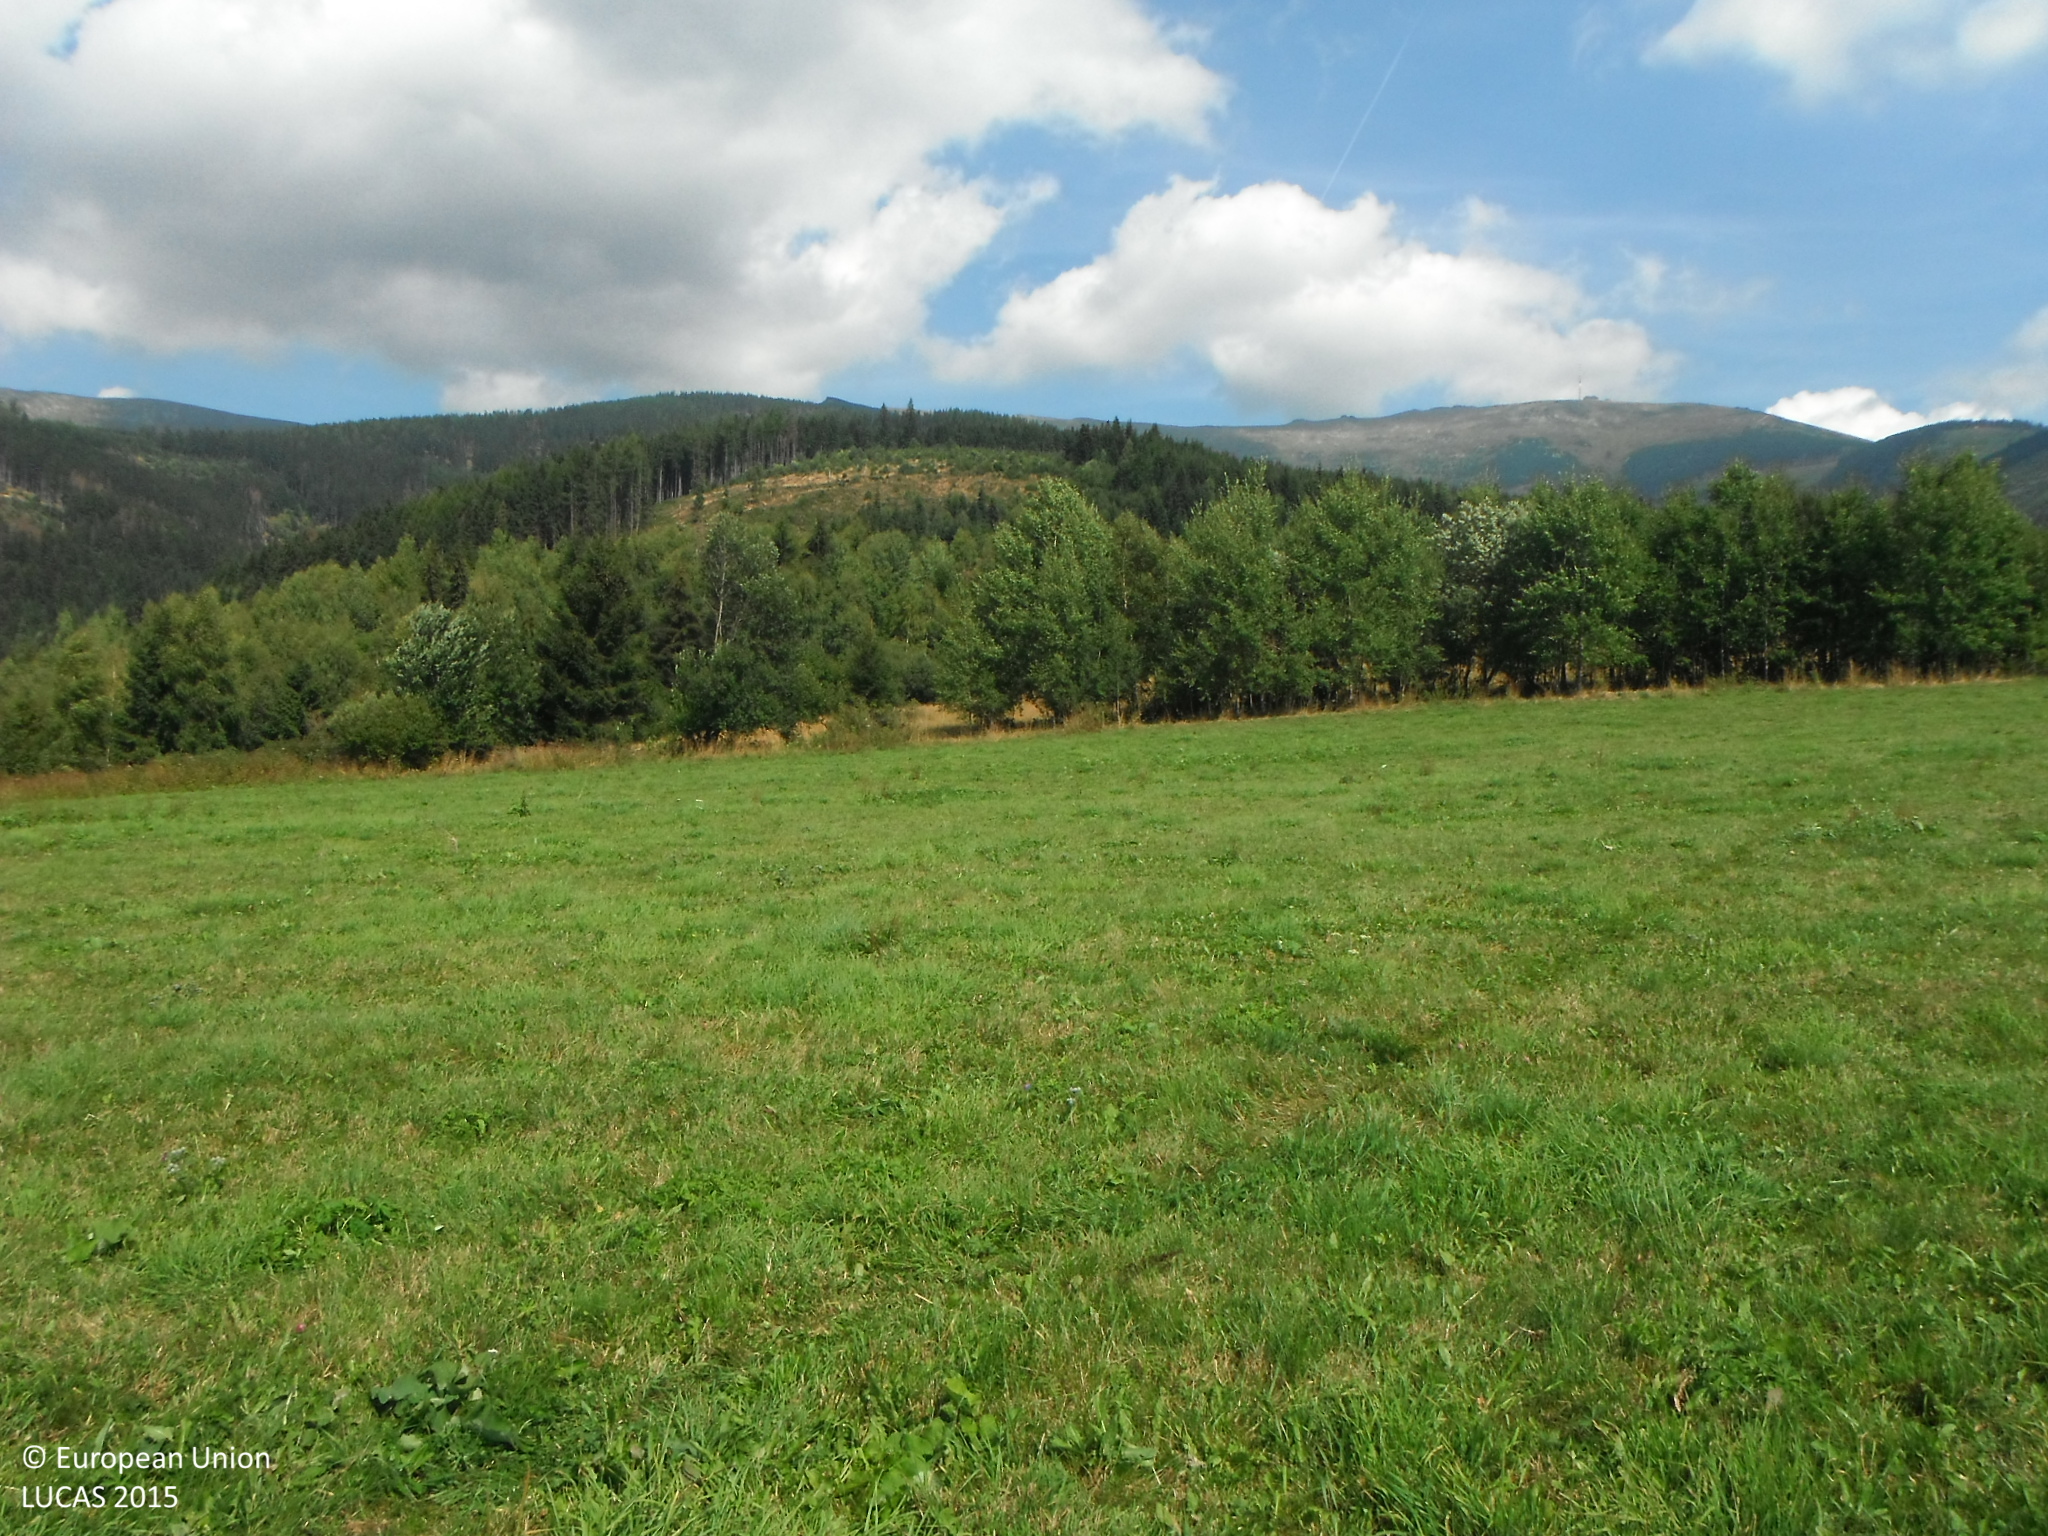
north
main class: Grassland
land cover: Grassland without tree/shrub cover
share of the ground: > 75 %
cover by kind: herbaceous plants 100 %
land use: Agriculture (excluding fallow land and kitchen gardens)
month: August
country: SK
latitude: 48.8462
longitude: 20.1017
